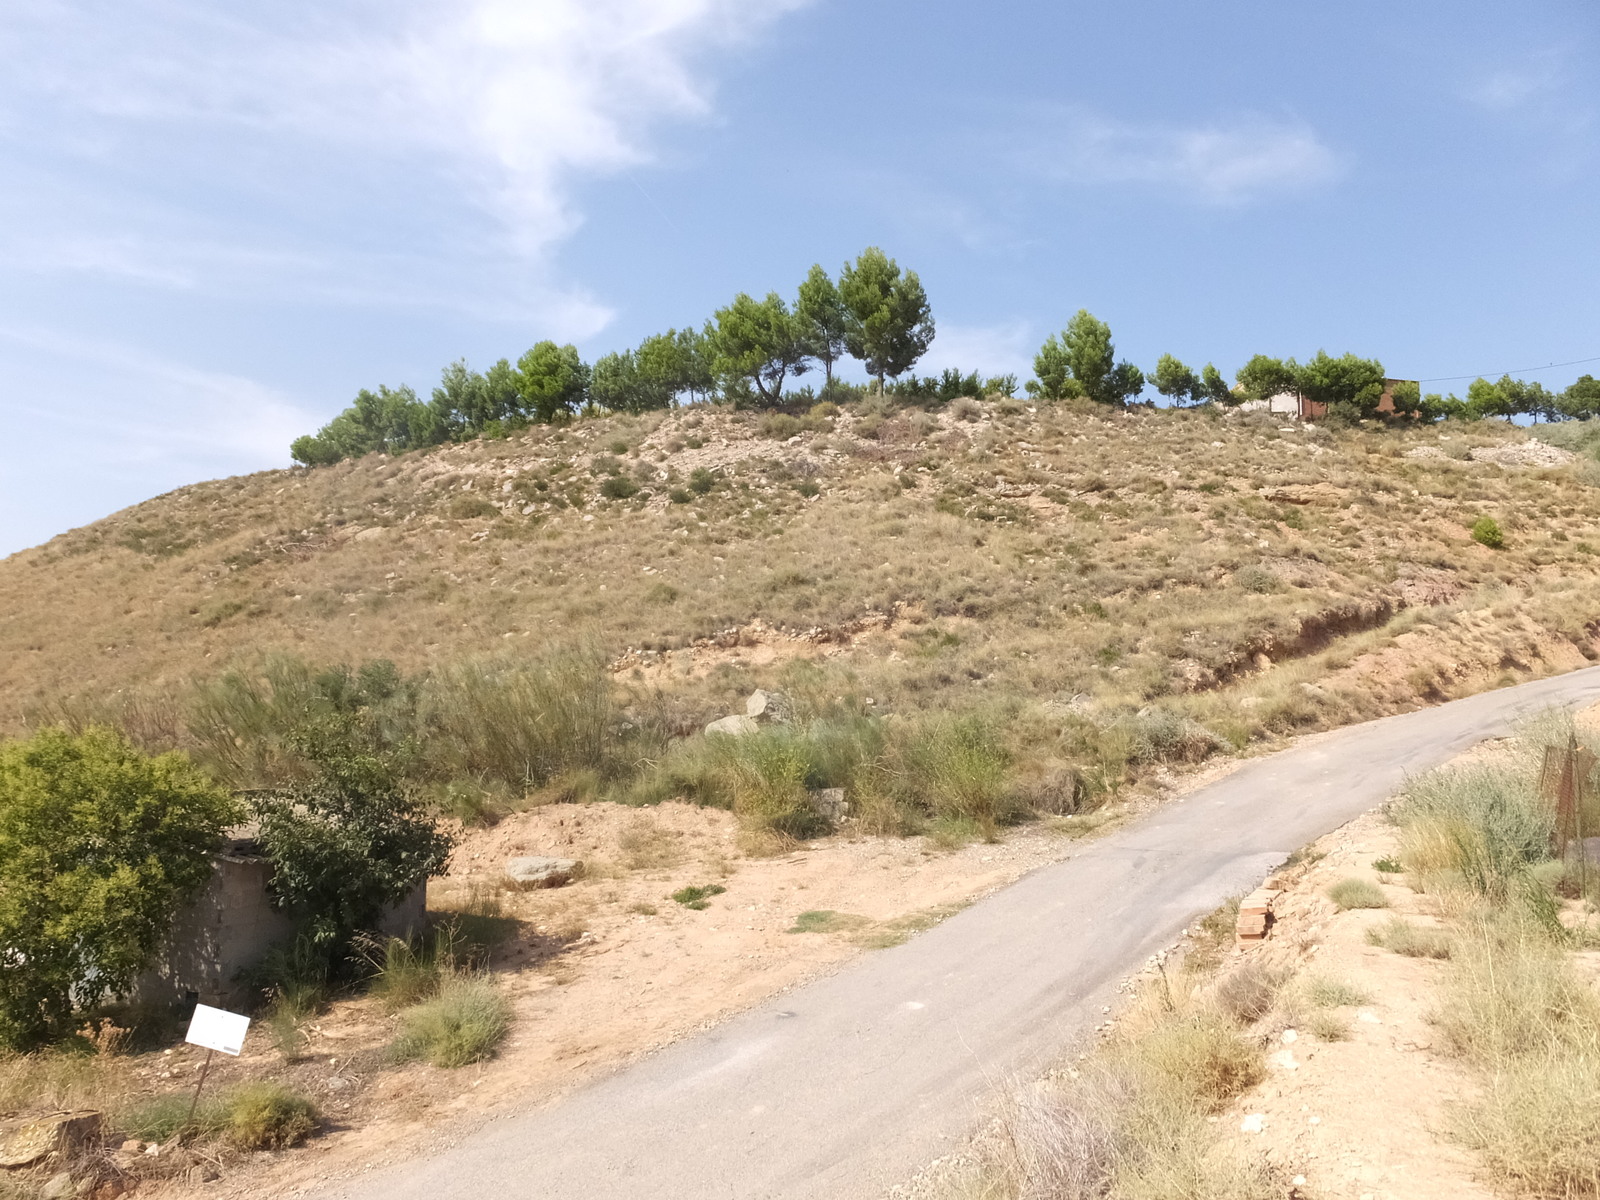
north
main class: Grassland
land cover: Grassland without tree/shrub cover
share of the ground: > 75 %
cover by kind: herbaceous plants 55 %, unconsolidated bare surface 40 %, shrubs 5 %
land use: Semi-natural and natural areas not in use
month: August
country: ES
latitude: 41.5389
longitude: 0.3618
